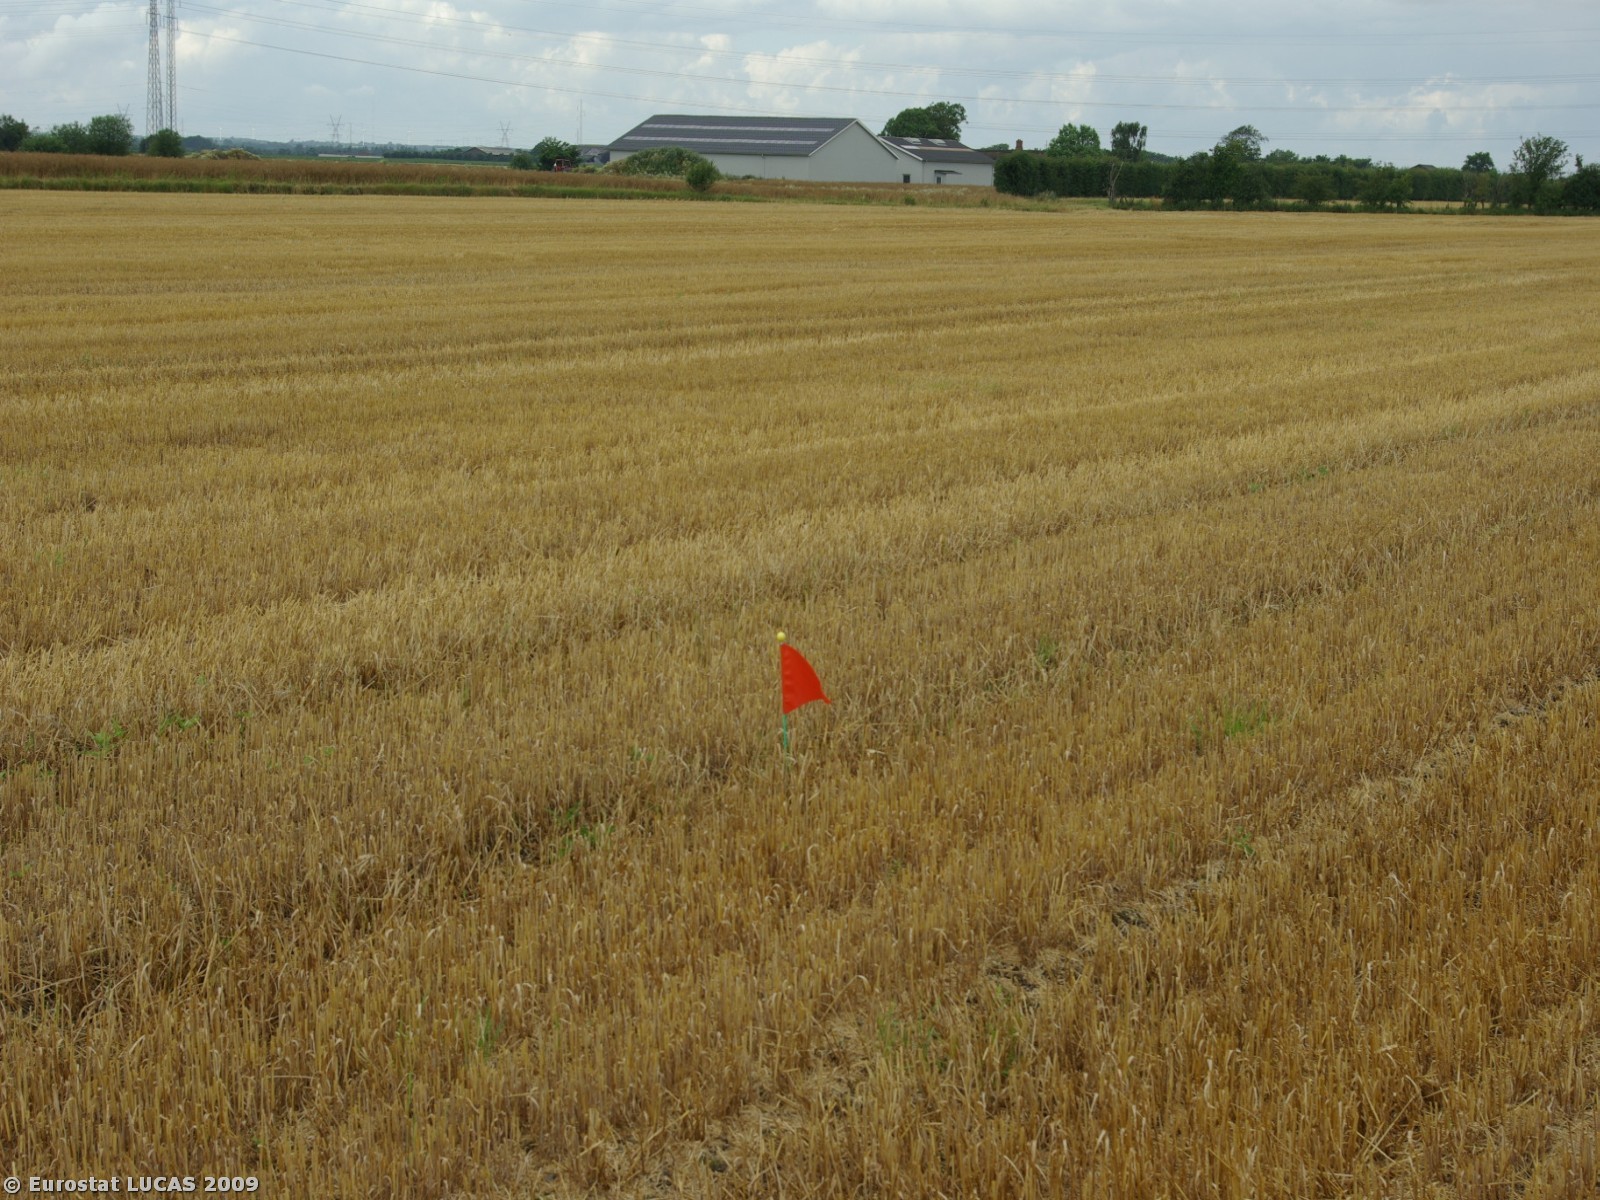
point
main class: Cropland
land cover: Barley
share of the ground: < 10 %
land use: Agriculture (excluding fallow land and kitchen gardens)
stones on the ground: > 50 %
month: July
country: DK
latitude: 55.0354
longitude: 9.2965
